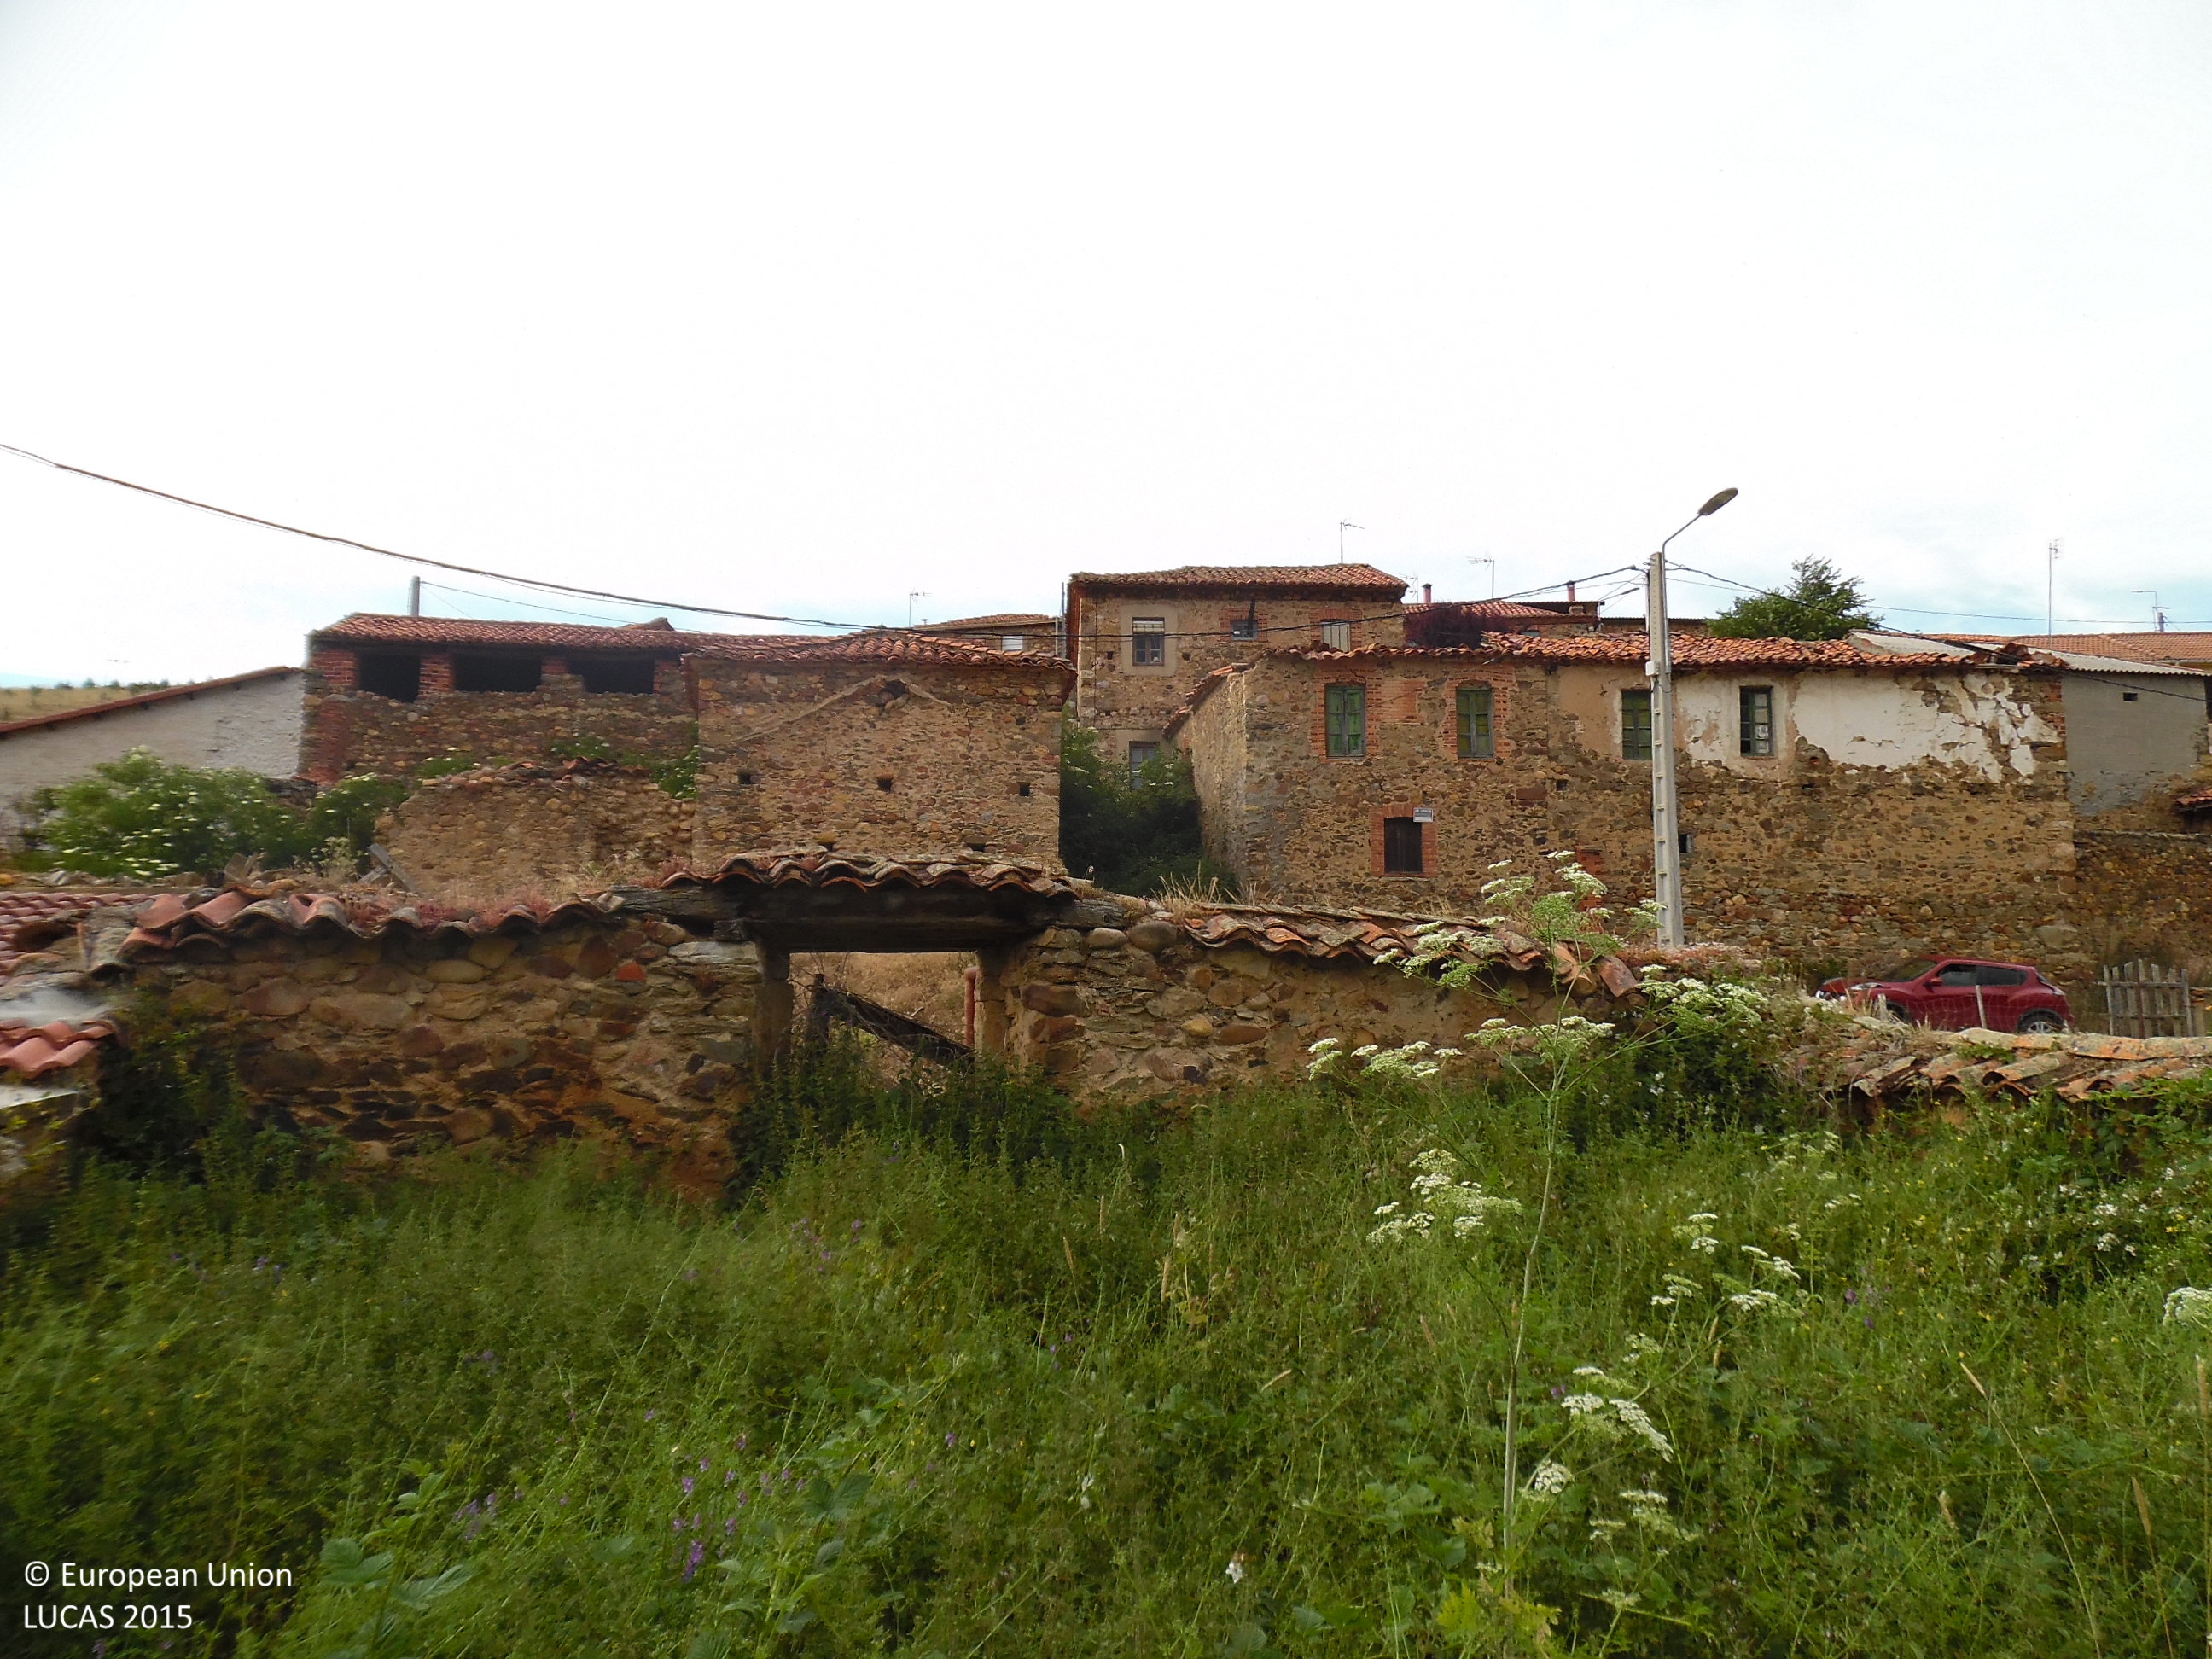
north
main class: Grassland
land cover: Spontaneously vegetated surfaces
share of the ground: > 75 %
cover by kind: herbaceous plants 95 %, shrubs 5 %
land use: Abandoned areas
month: June
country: ES
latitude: 42.7702
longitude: -5.7587
